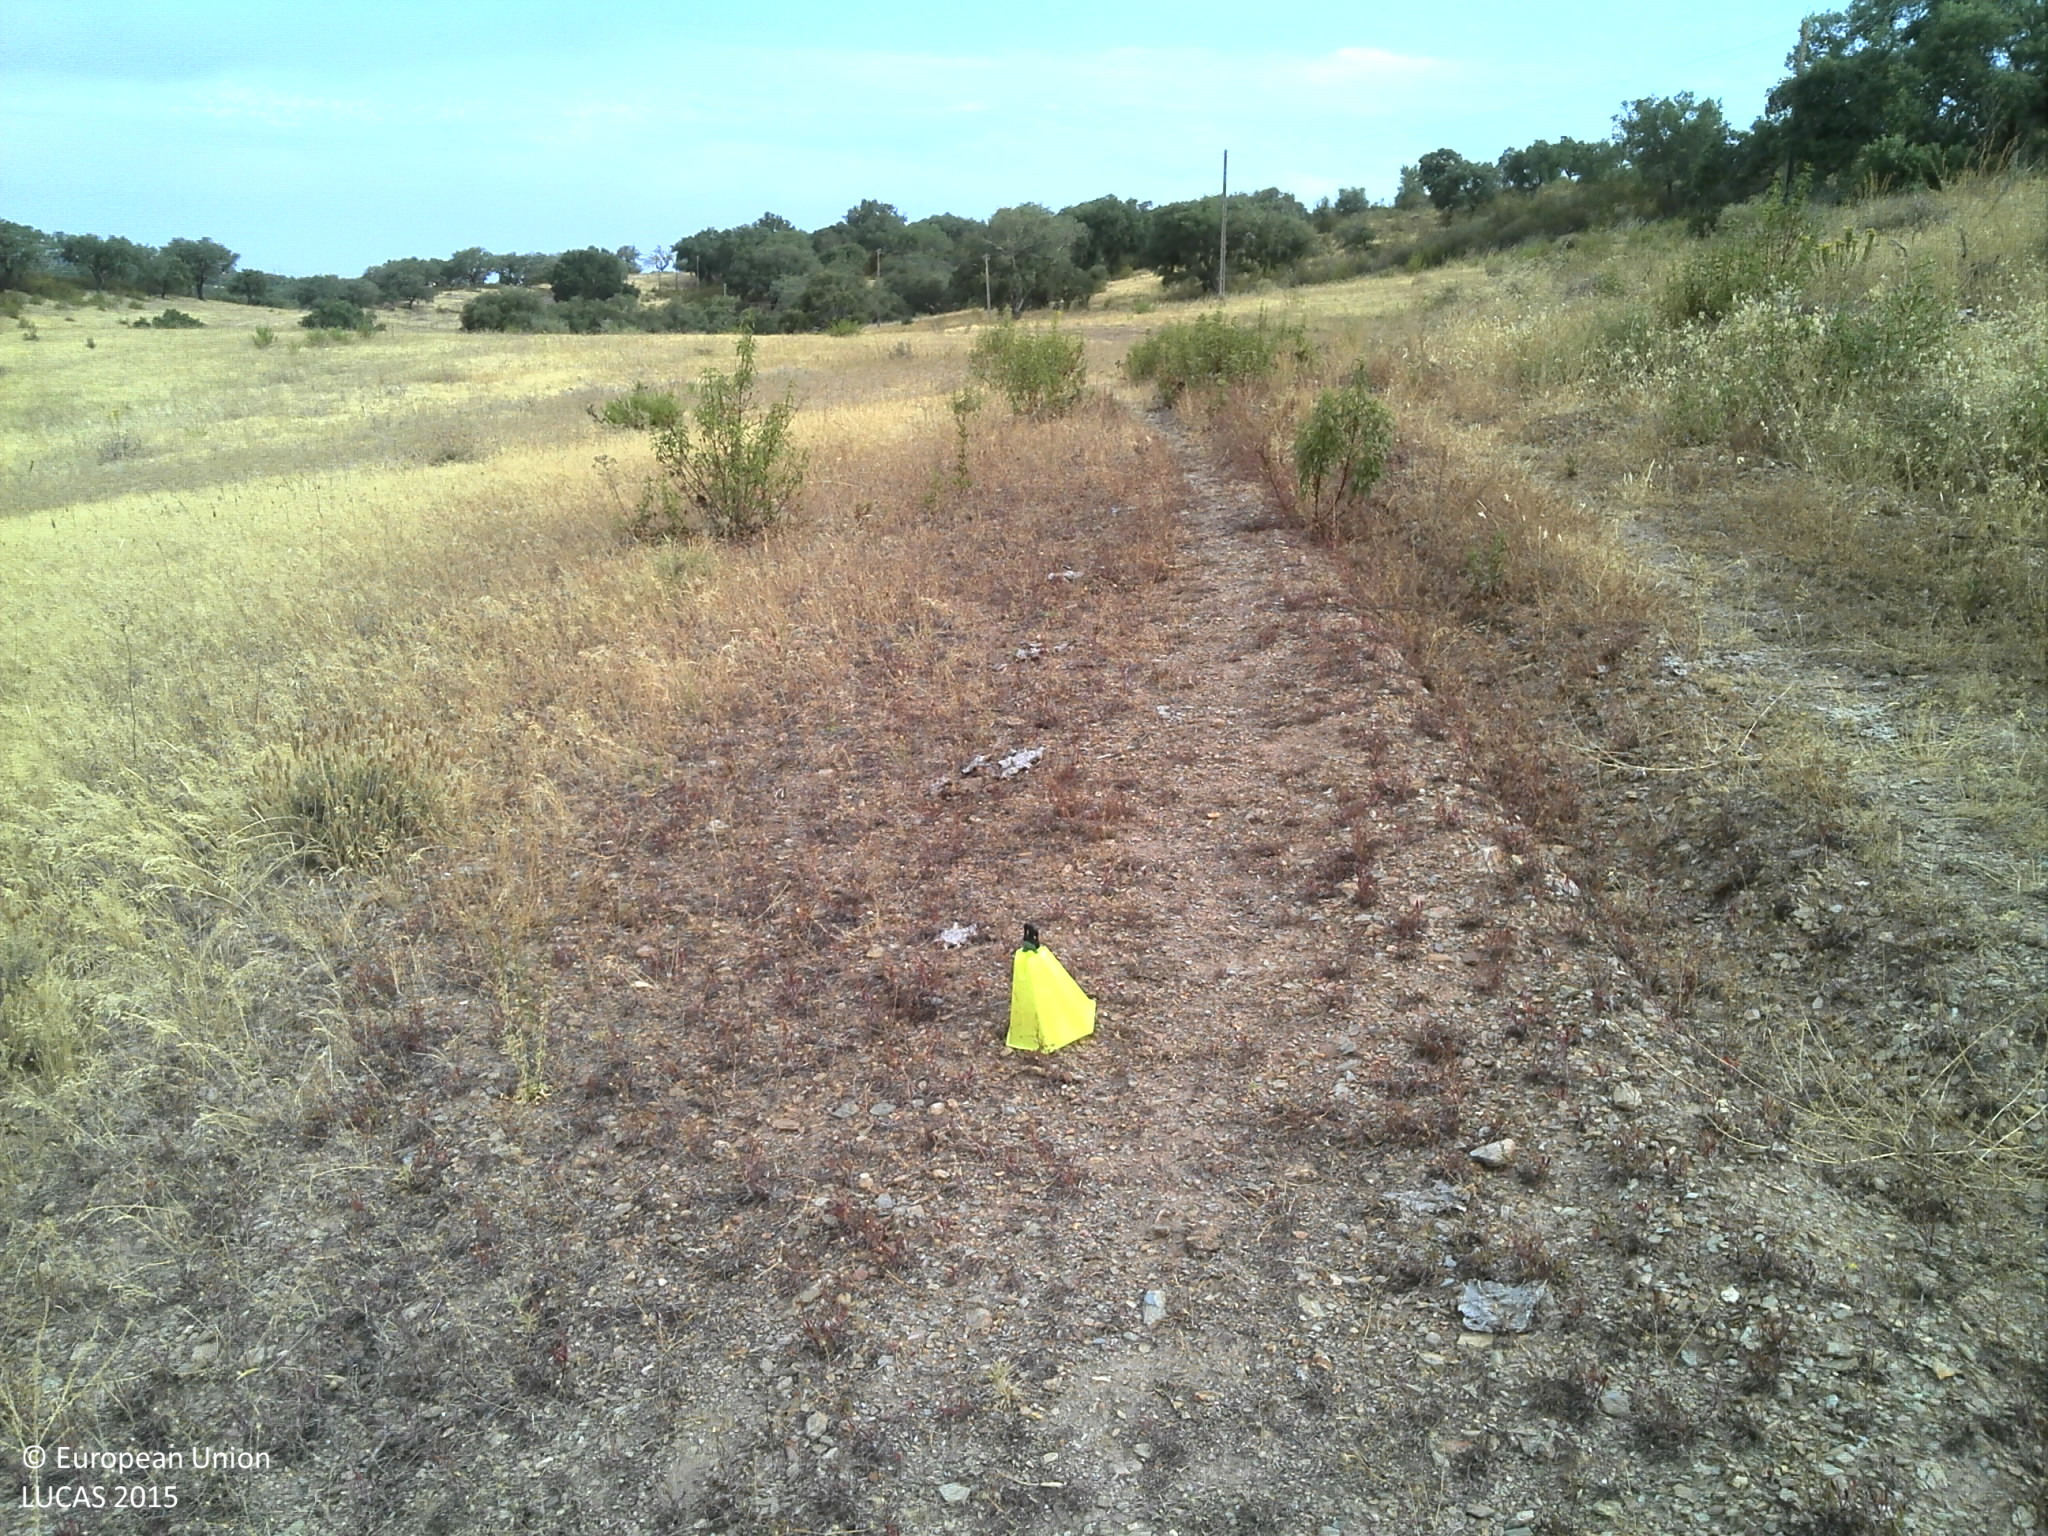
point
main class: Woodland
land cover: Broadleaved woodland
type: broadleaved evergreen forest
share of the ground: 10 - 25 %
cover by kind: herbaceous plants 40 %, broadleaved forest trees 25 %, shrubs 25 %, unconsolidated bare surface 10 %
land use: Forestry
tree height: > 5 m
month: July
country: PT
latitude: 38.7698
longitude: -7.5168
